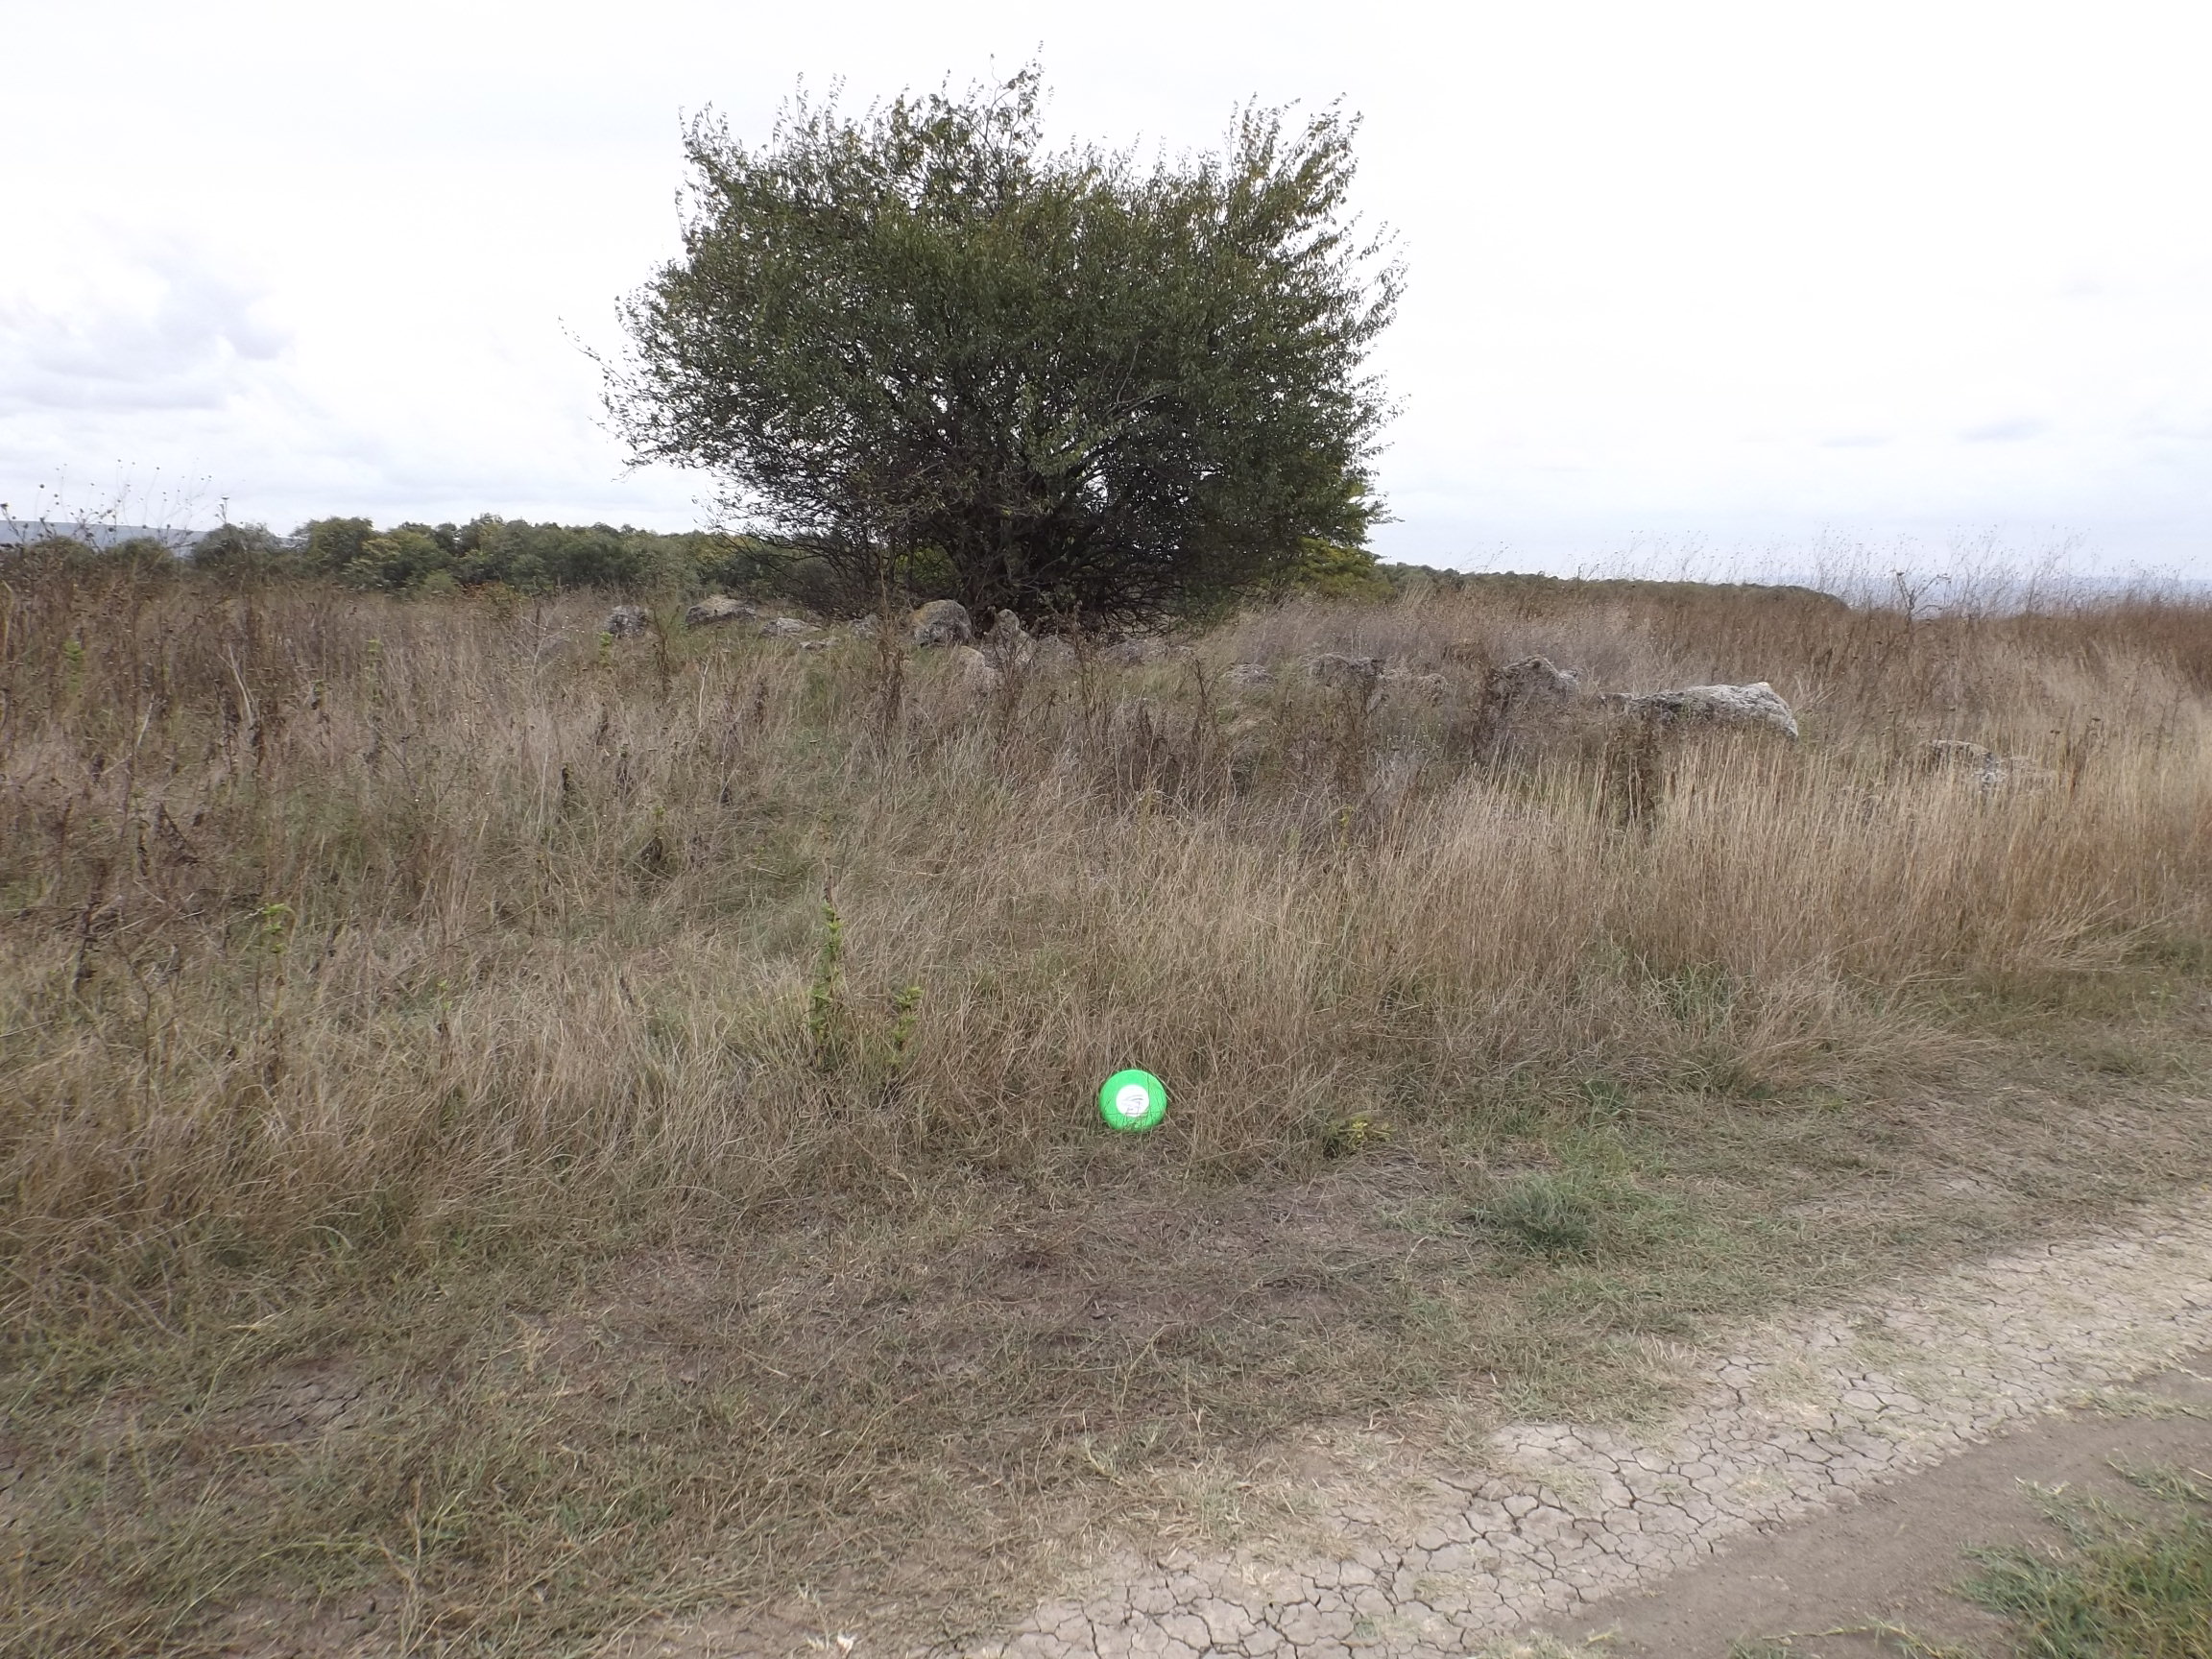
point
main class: Grassland
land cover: Spontaneously vegetated surfaces
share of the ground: > 75 %
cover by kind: herbaceous plants 95 %, shrubs 5 %
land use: Semi-natural and natural areas not in use
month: September
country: BG
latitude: 43.1706
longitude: 27.5587
